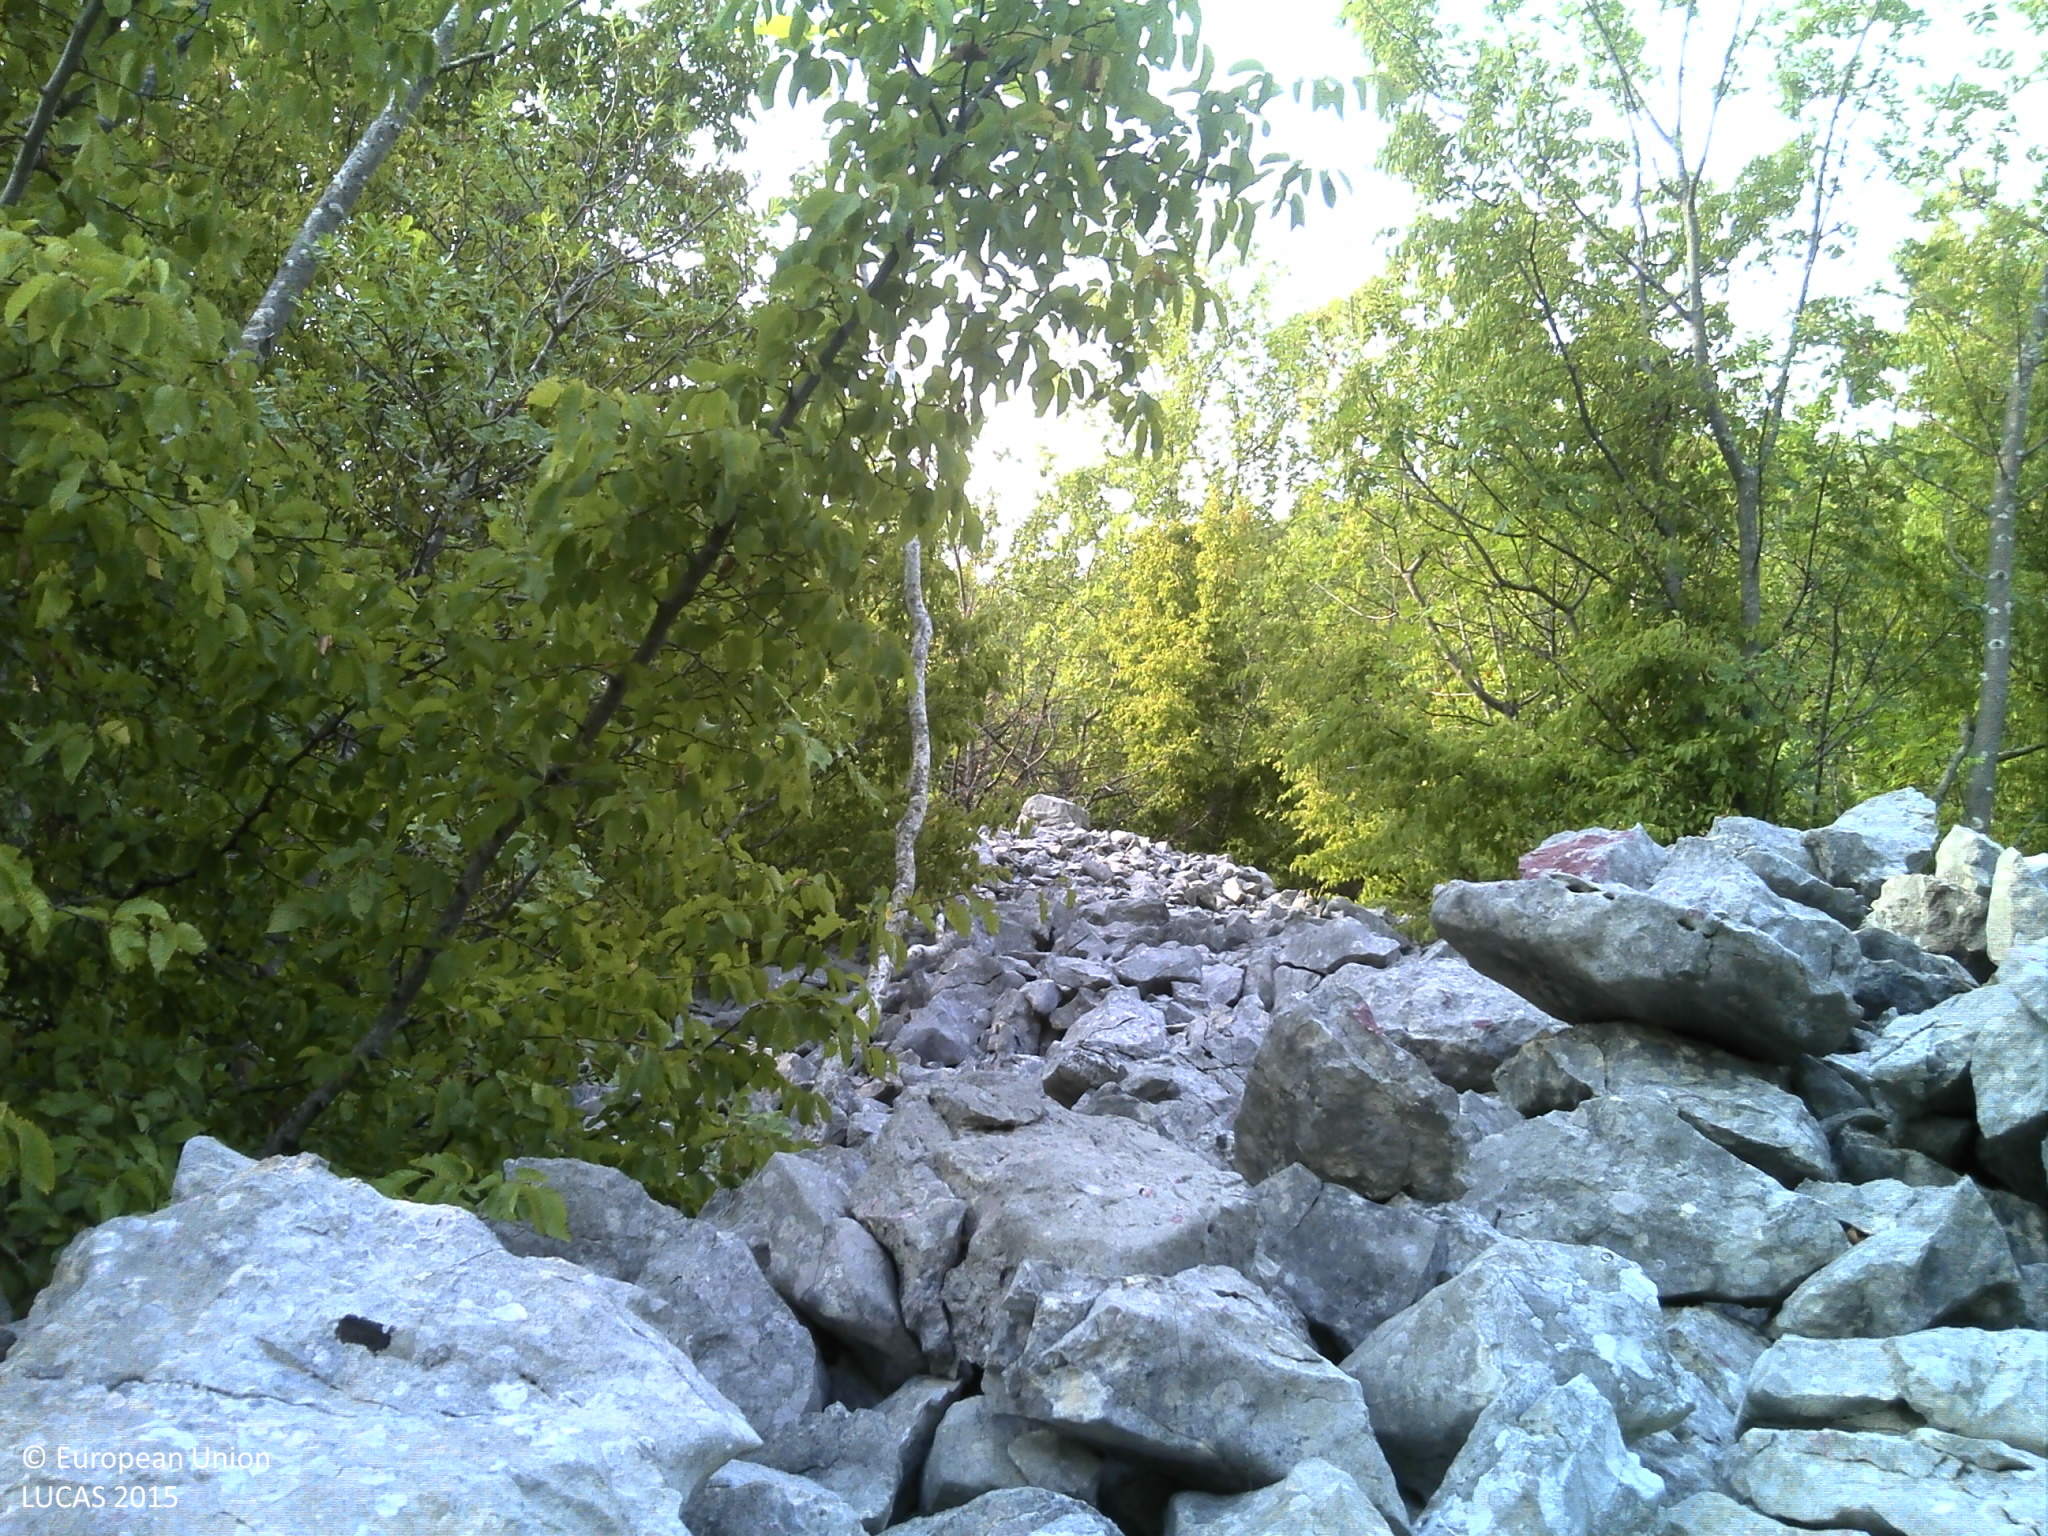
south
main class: Shrubland
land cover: Shrubland with sparse tree cover
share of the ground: > 75 %
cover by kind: shrubs 75 %, herbaceous plants 10 %, consolidated bare surface 10 %, broadleaved forest trees 5 %
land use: Abandoned areas
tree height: < 5 m
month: August
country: HR
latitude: 43.2460
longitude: 17.2452
